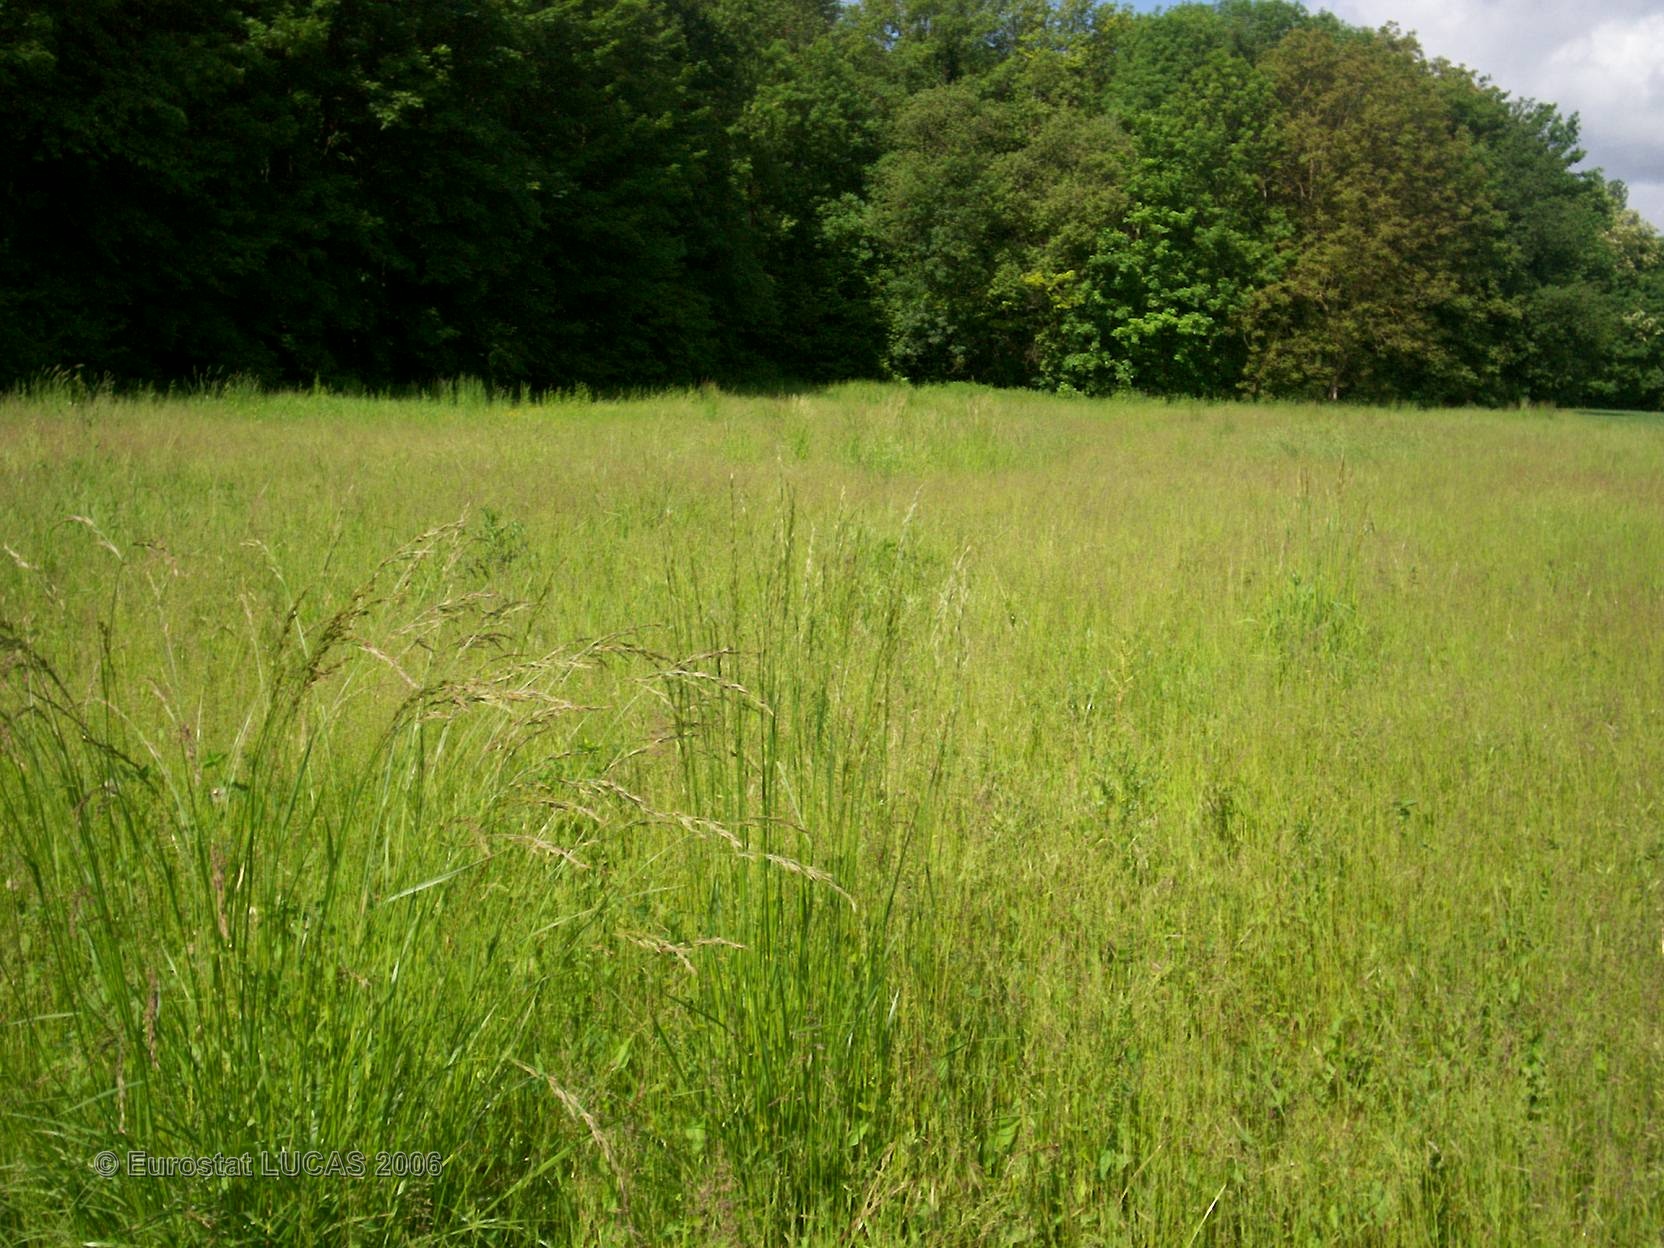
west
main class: Grassland
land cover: Grassland without tree/shrub cover
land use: Agriculture (excluding fallow land and kitchen gardens)
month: May
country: FR
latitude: 48.4261
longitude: 4.4429
